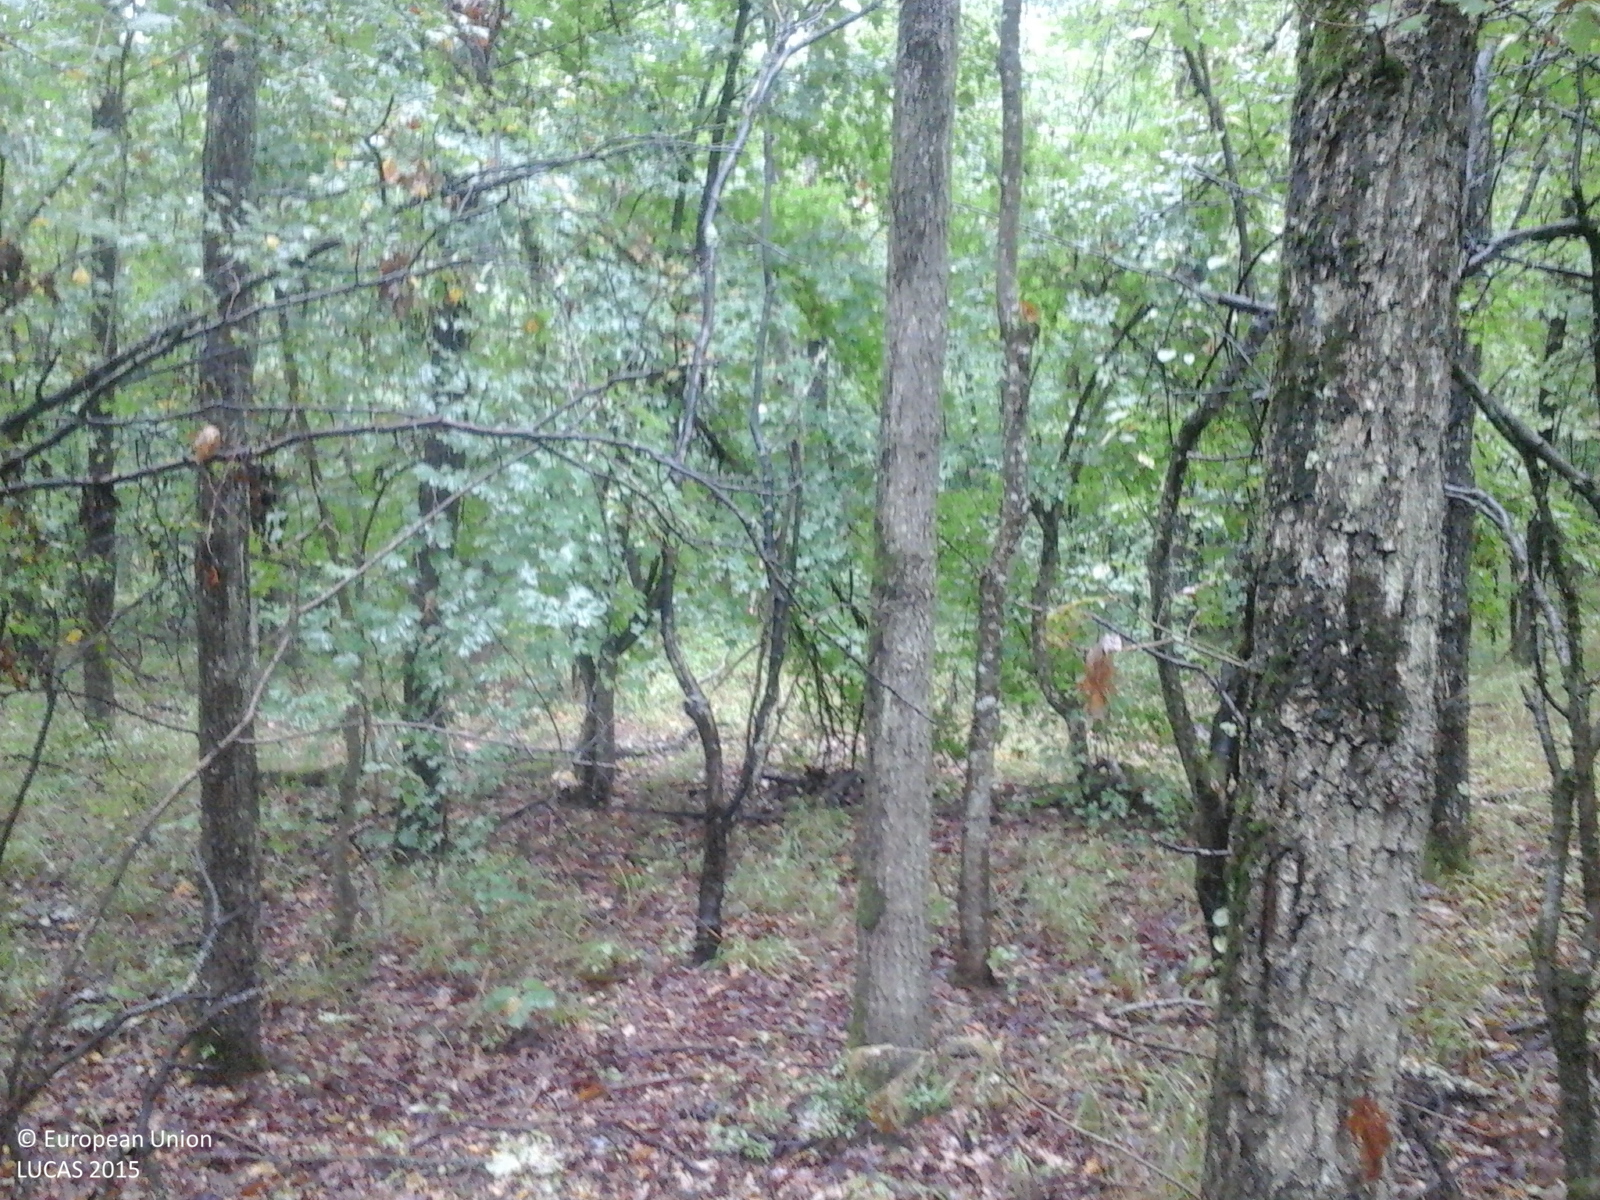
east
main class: Woodland
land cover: Broadleaved woodland
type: acidophilous oak and oak-birch forest
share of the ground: > 75 %
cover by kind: broadleaved forest trees 100 %
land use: Forestry
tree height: > 5 m
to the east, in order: Broadleaved woodland
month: August
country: RO
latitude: 45.7128
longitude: 21.4792
